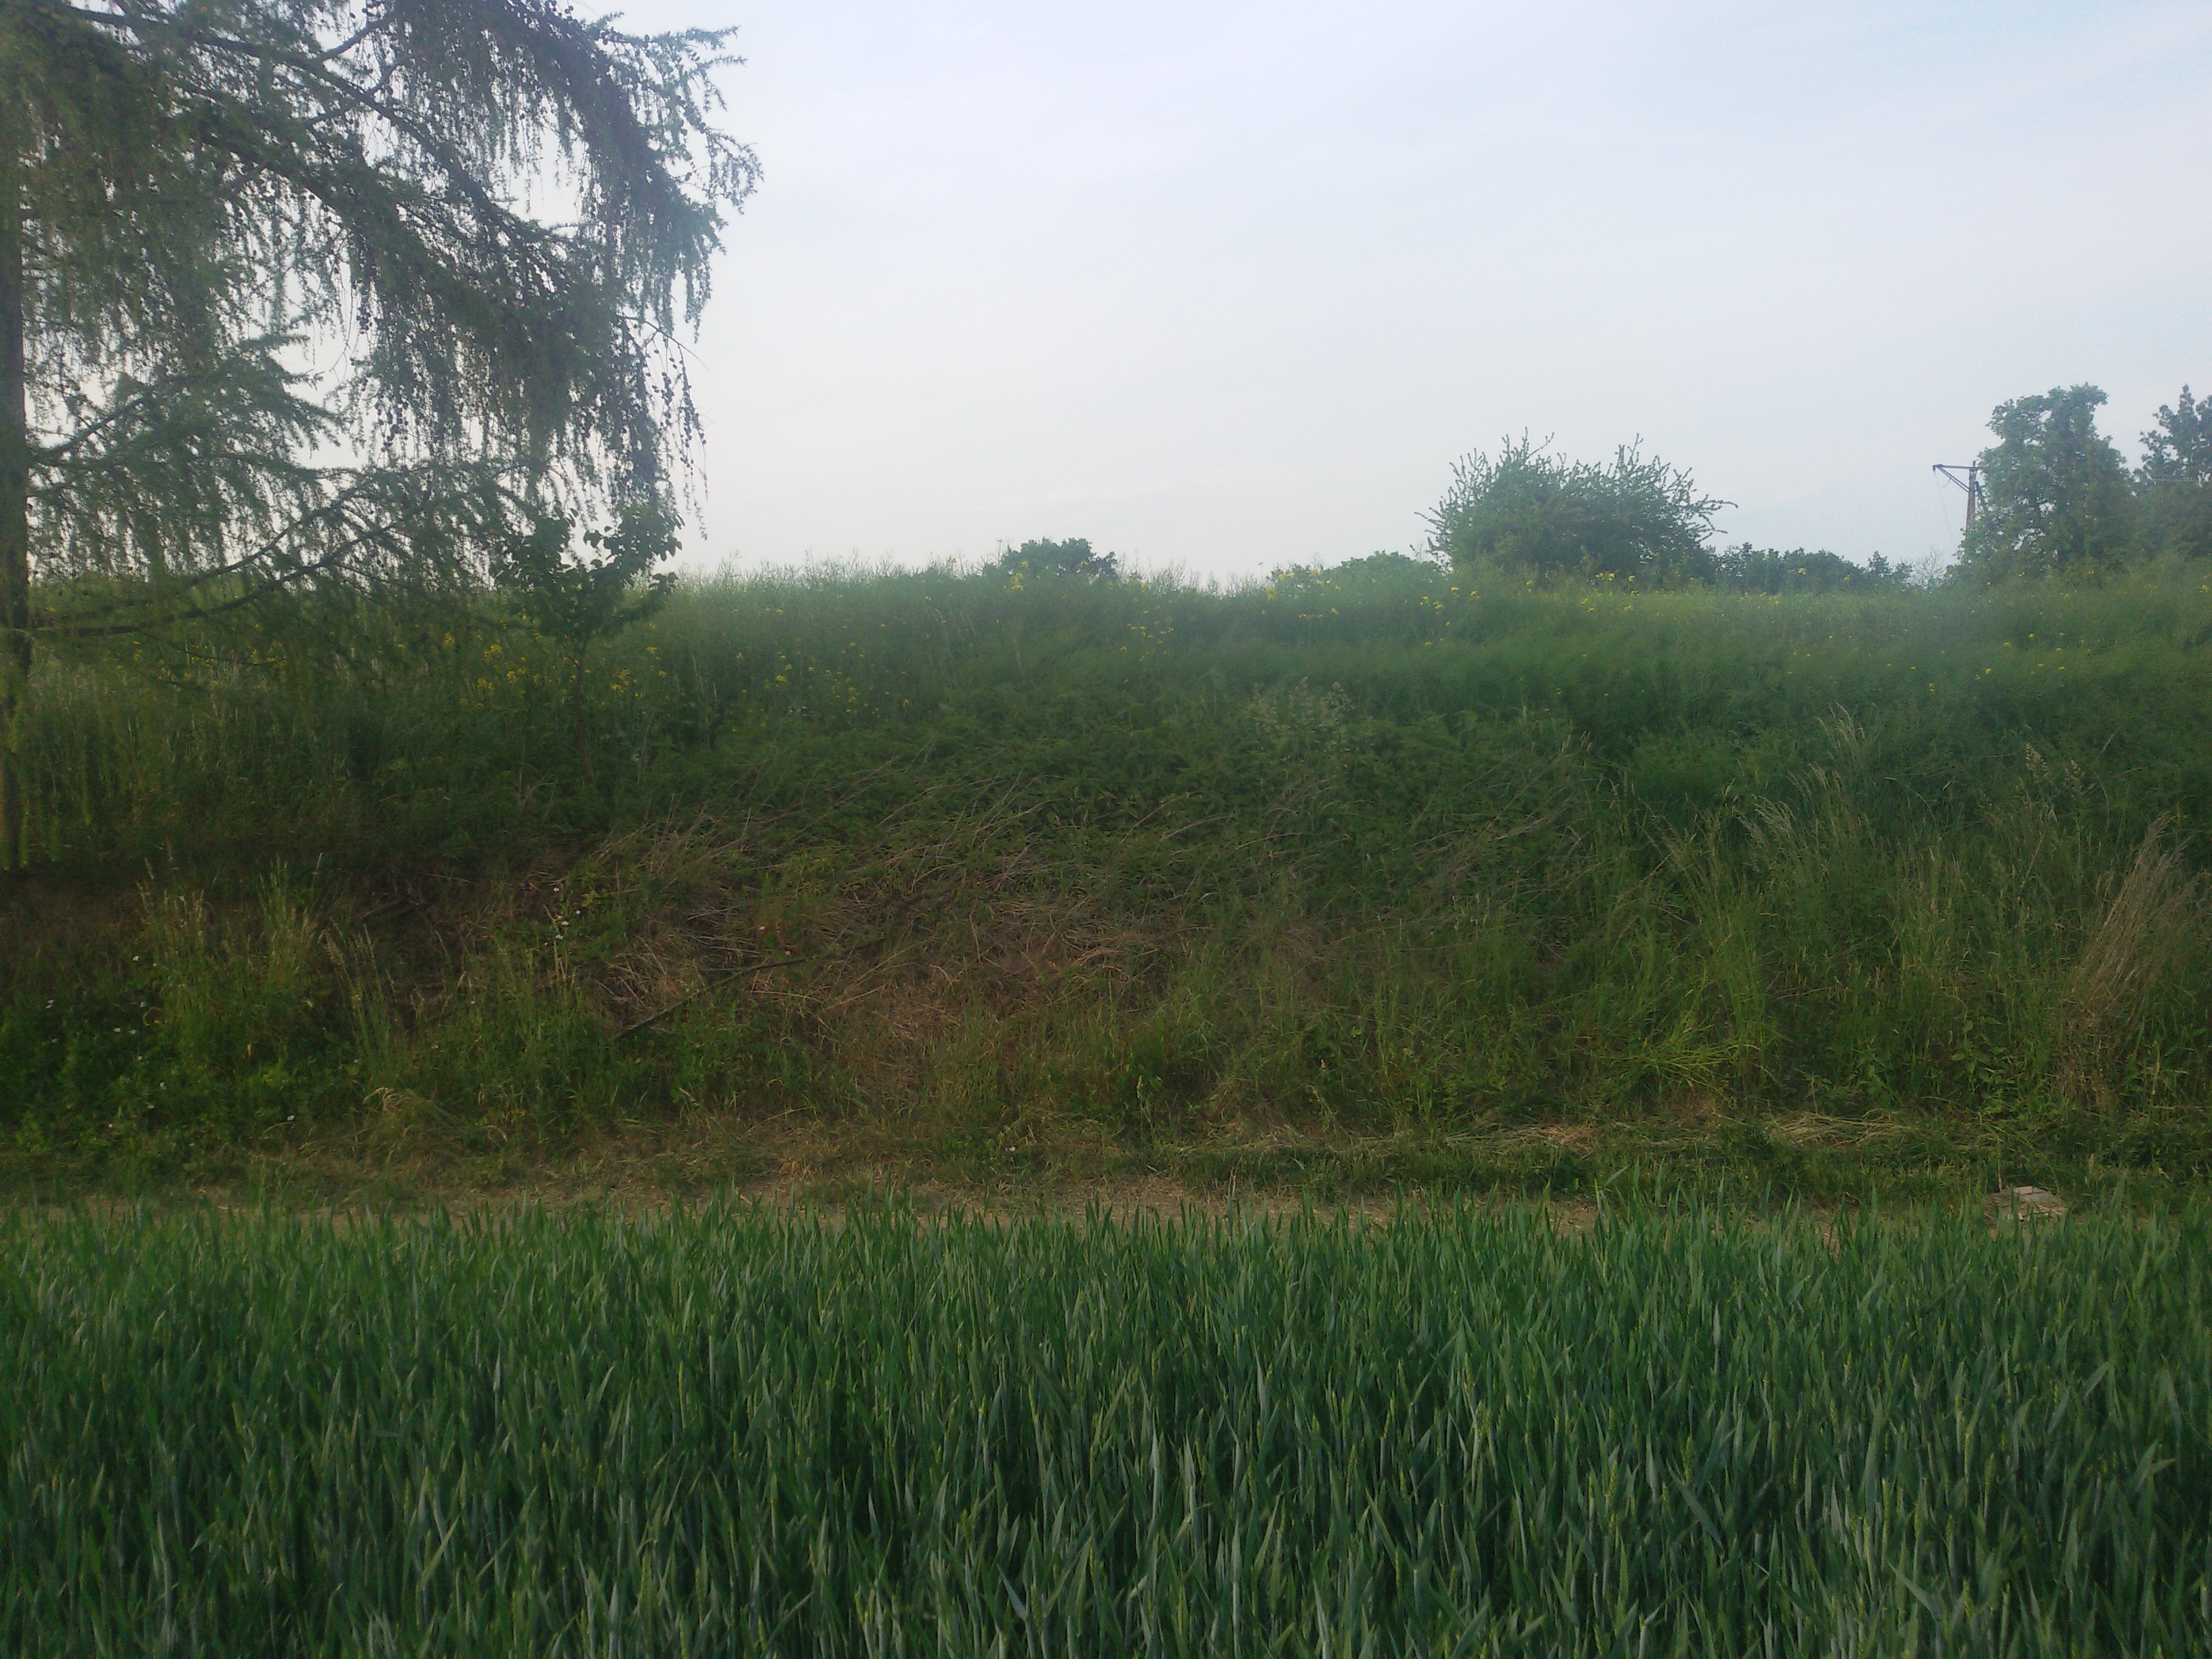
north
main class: Cropland
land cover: Common wheat
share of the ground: > 75 %
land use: Agriculture (excluding fallow land and kitchen gardens)
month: May
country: PL
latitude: 50.5490
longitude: 17.2513
